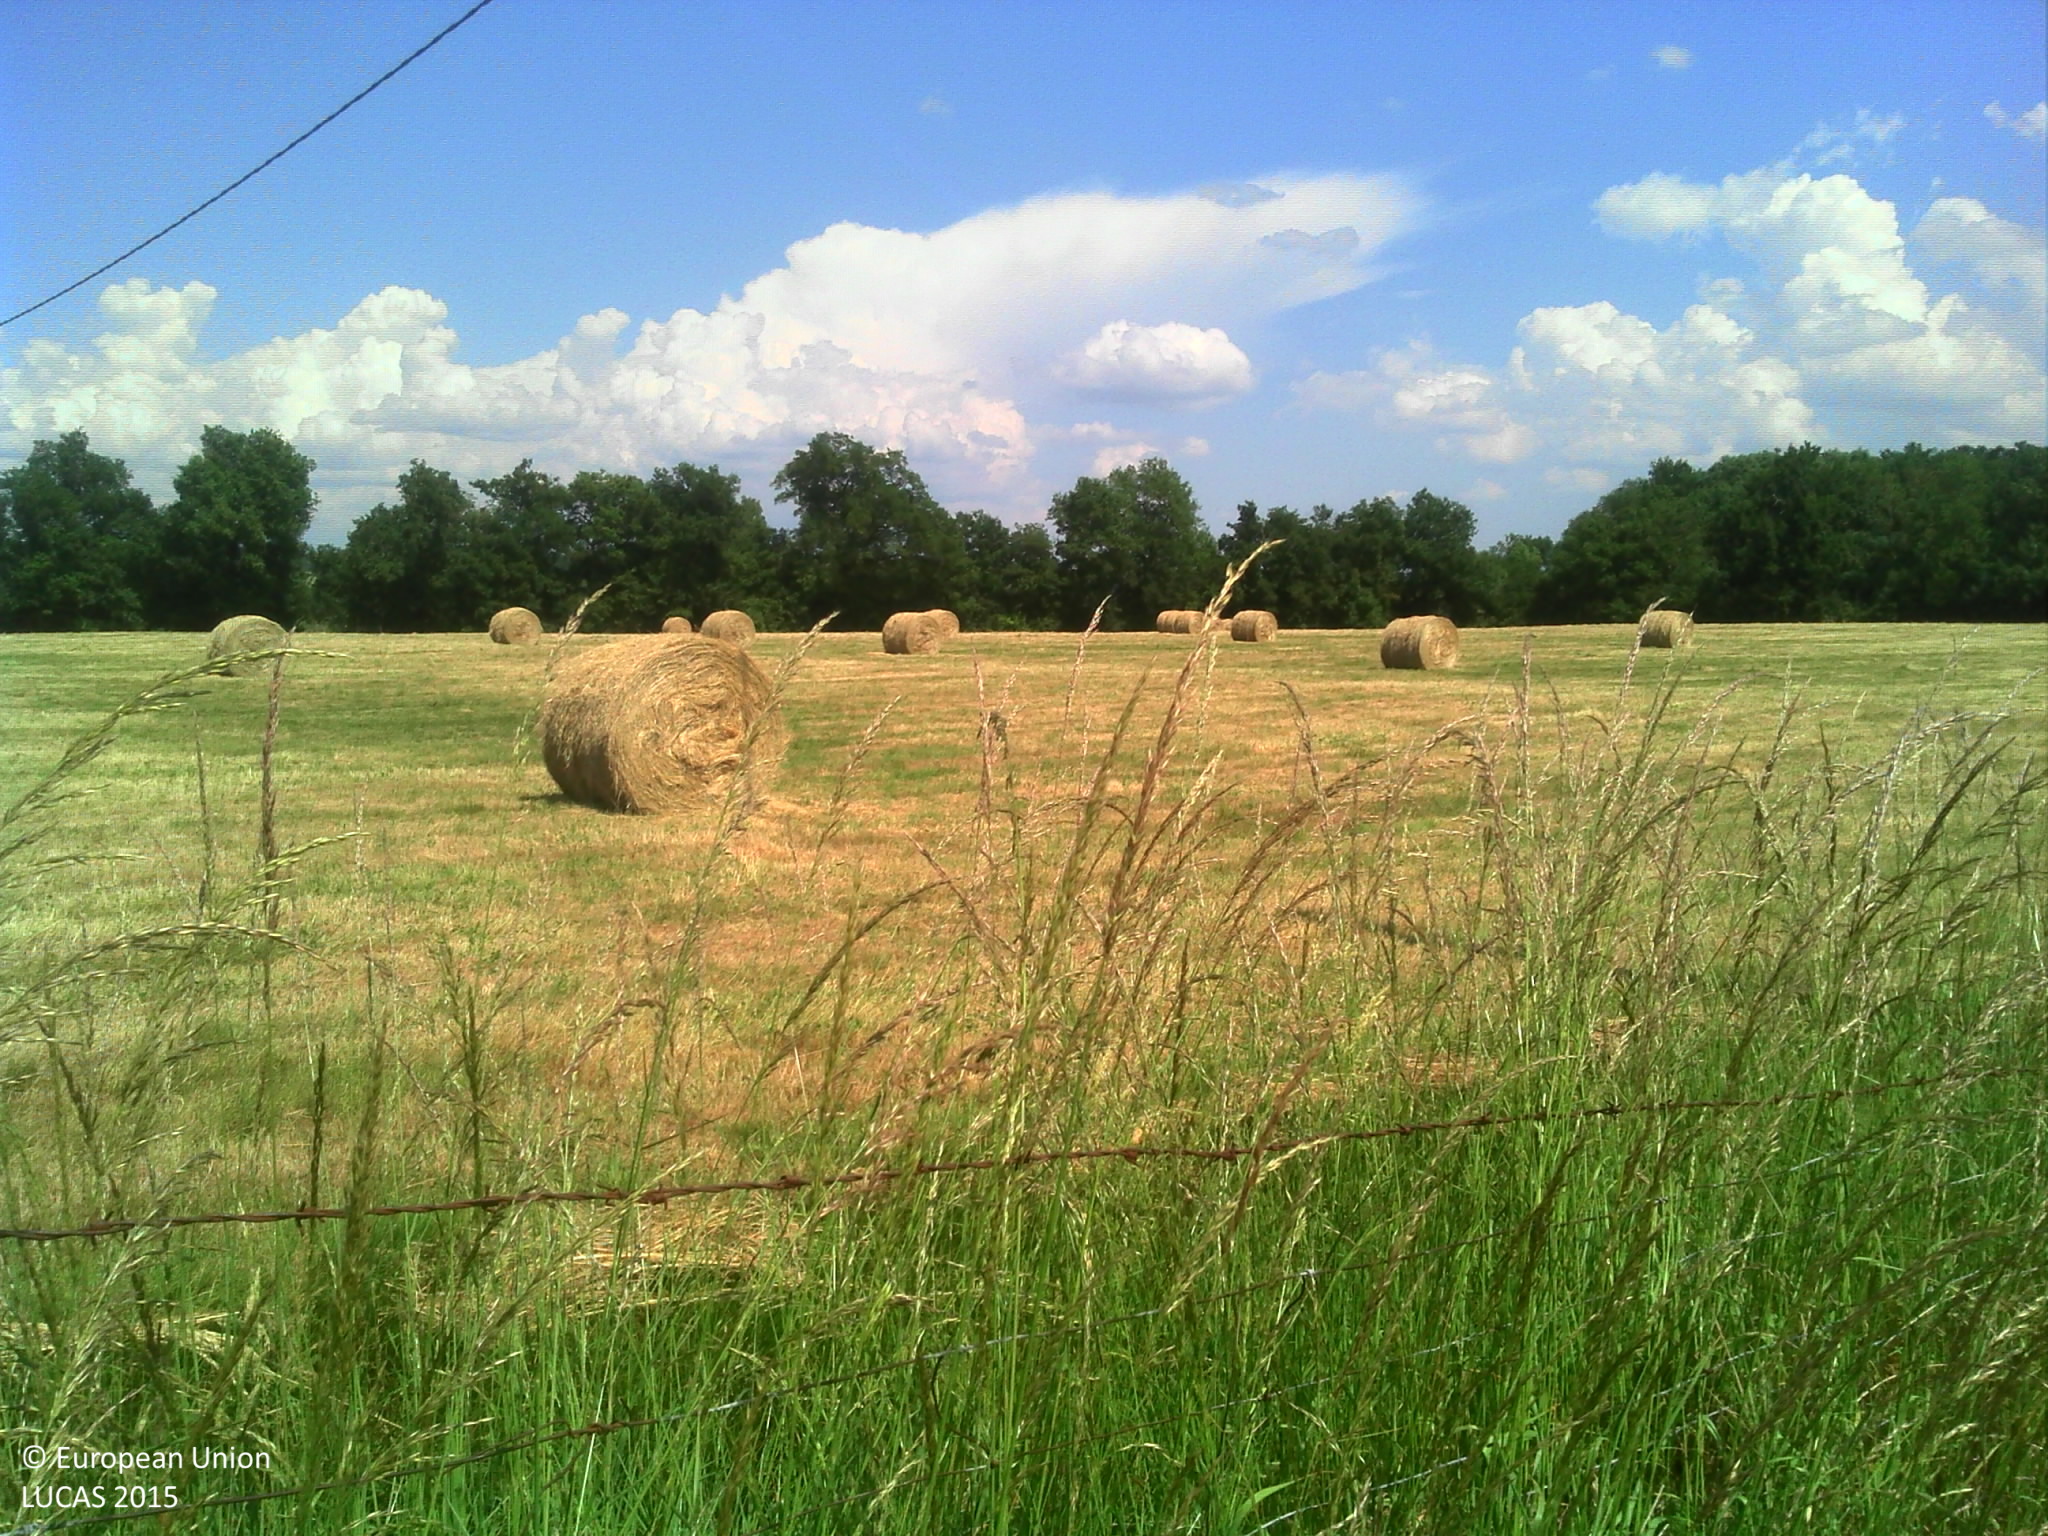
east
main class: Grassland
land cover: Grassland without tree/shrub cover
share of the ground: > 75 %
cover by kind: herbaceous plants 100 %
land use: Agriculture (excluding fallow land and kitchen gardens)
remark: Harvested field
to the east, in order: Grassland without tree/shrub cover; Electric lines; Grassland without tree/shrub cover; Fences; Broadleaved woodland; Other bare soil; Tracks; Broadleaved woodland; Arable land (only in case pi)
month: June
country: FR
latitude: 43.5632
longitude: 2.1441
